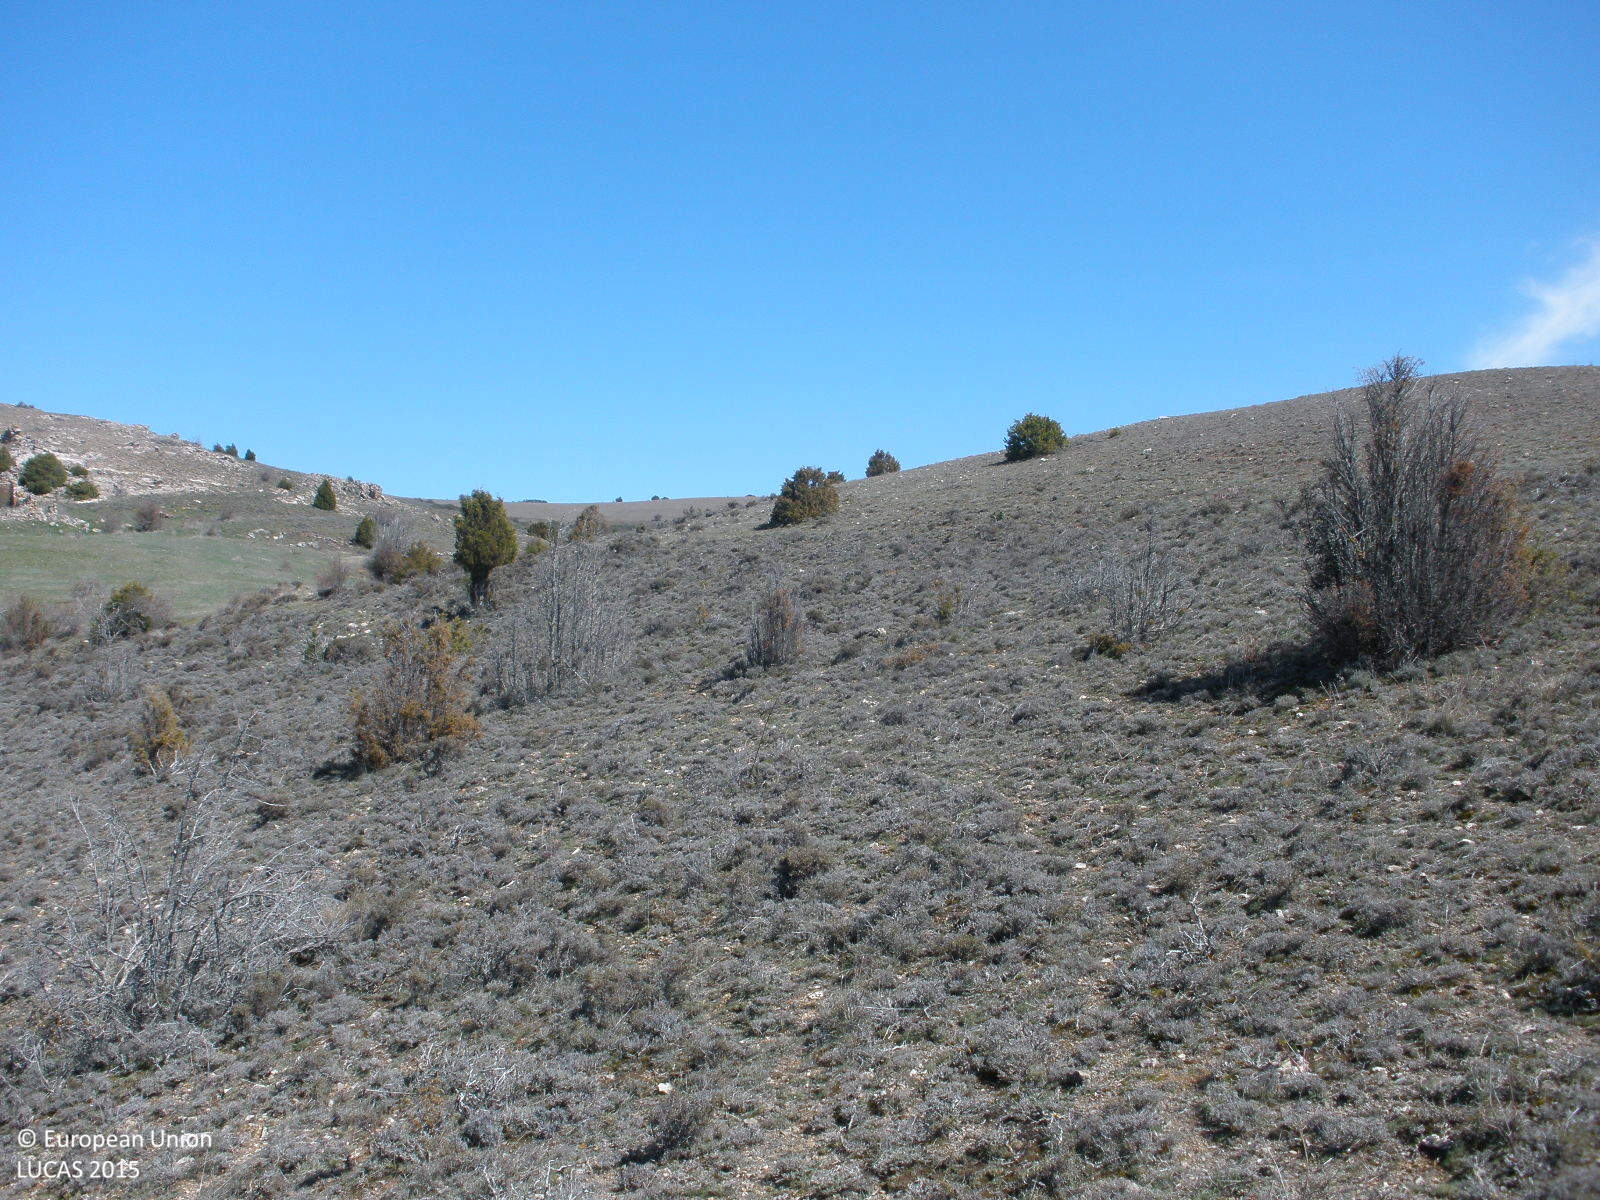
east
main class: Shrubland
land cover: Shrubland without tree cover
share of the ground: 50 - 75 %
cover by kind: shrubs 70 %, consolidated bare surface 30 %
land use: Semi-natural and natural areas not in use
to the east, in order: Shrubland without tree cover; Shrubland with sparse tree cover; Rock outcrops; Shrubland with sparse tree cover; Shrubland without tree cover
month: April
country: ES
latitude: 40.9818
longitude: -1.1300
